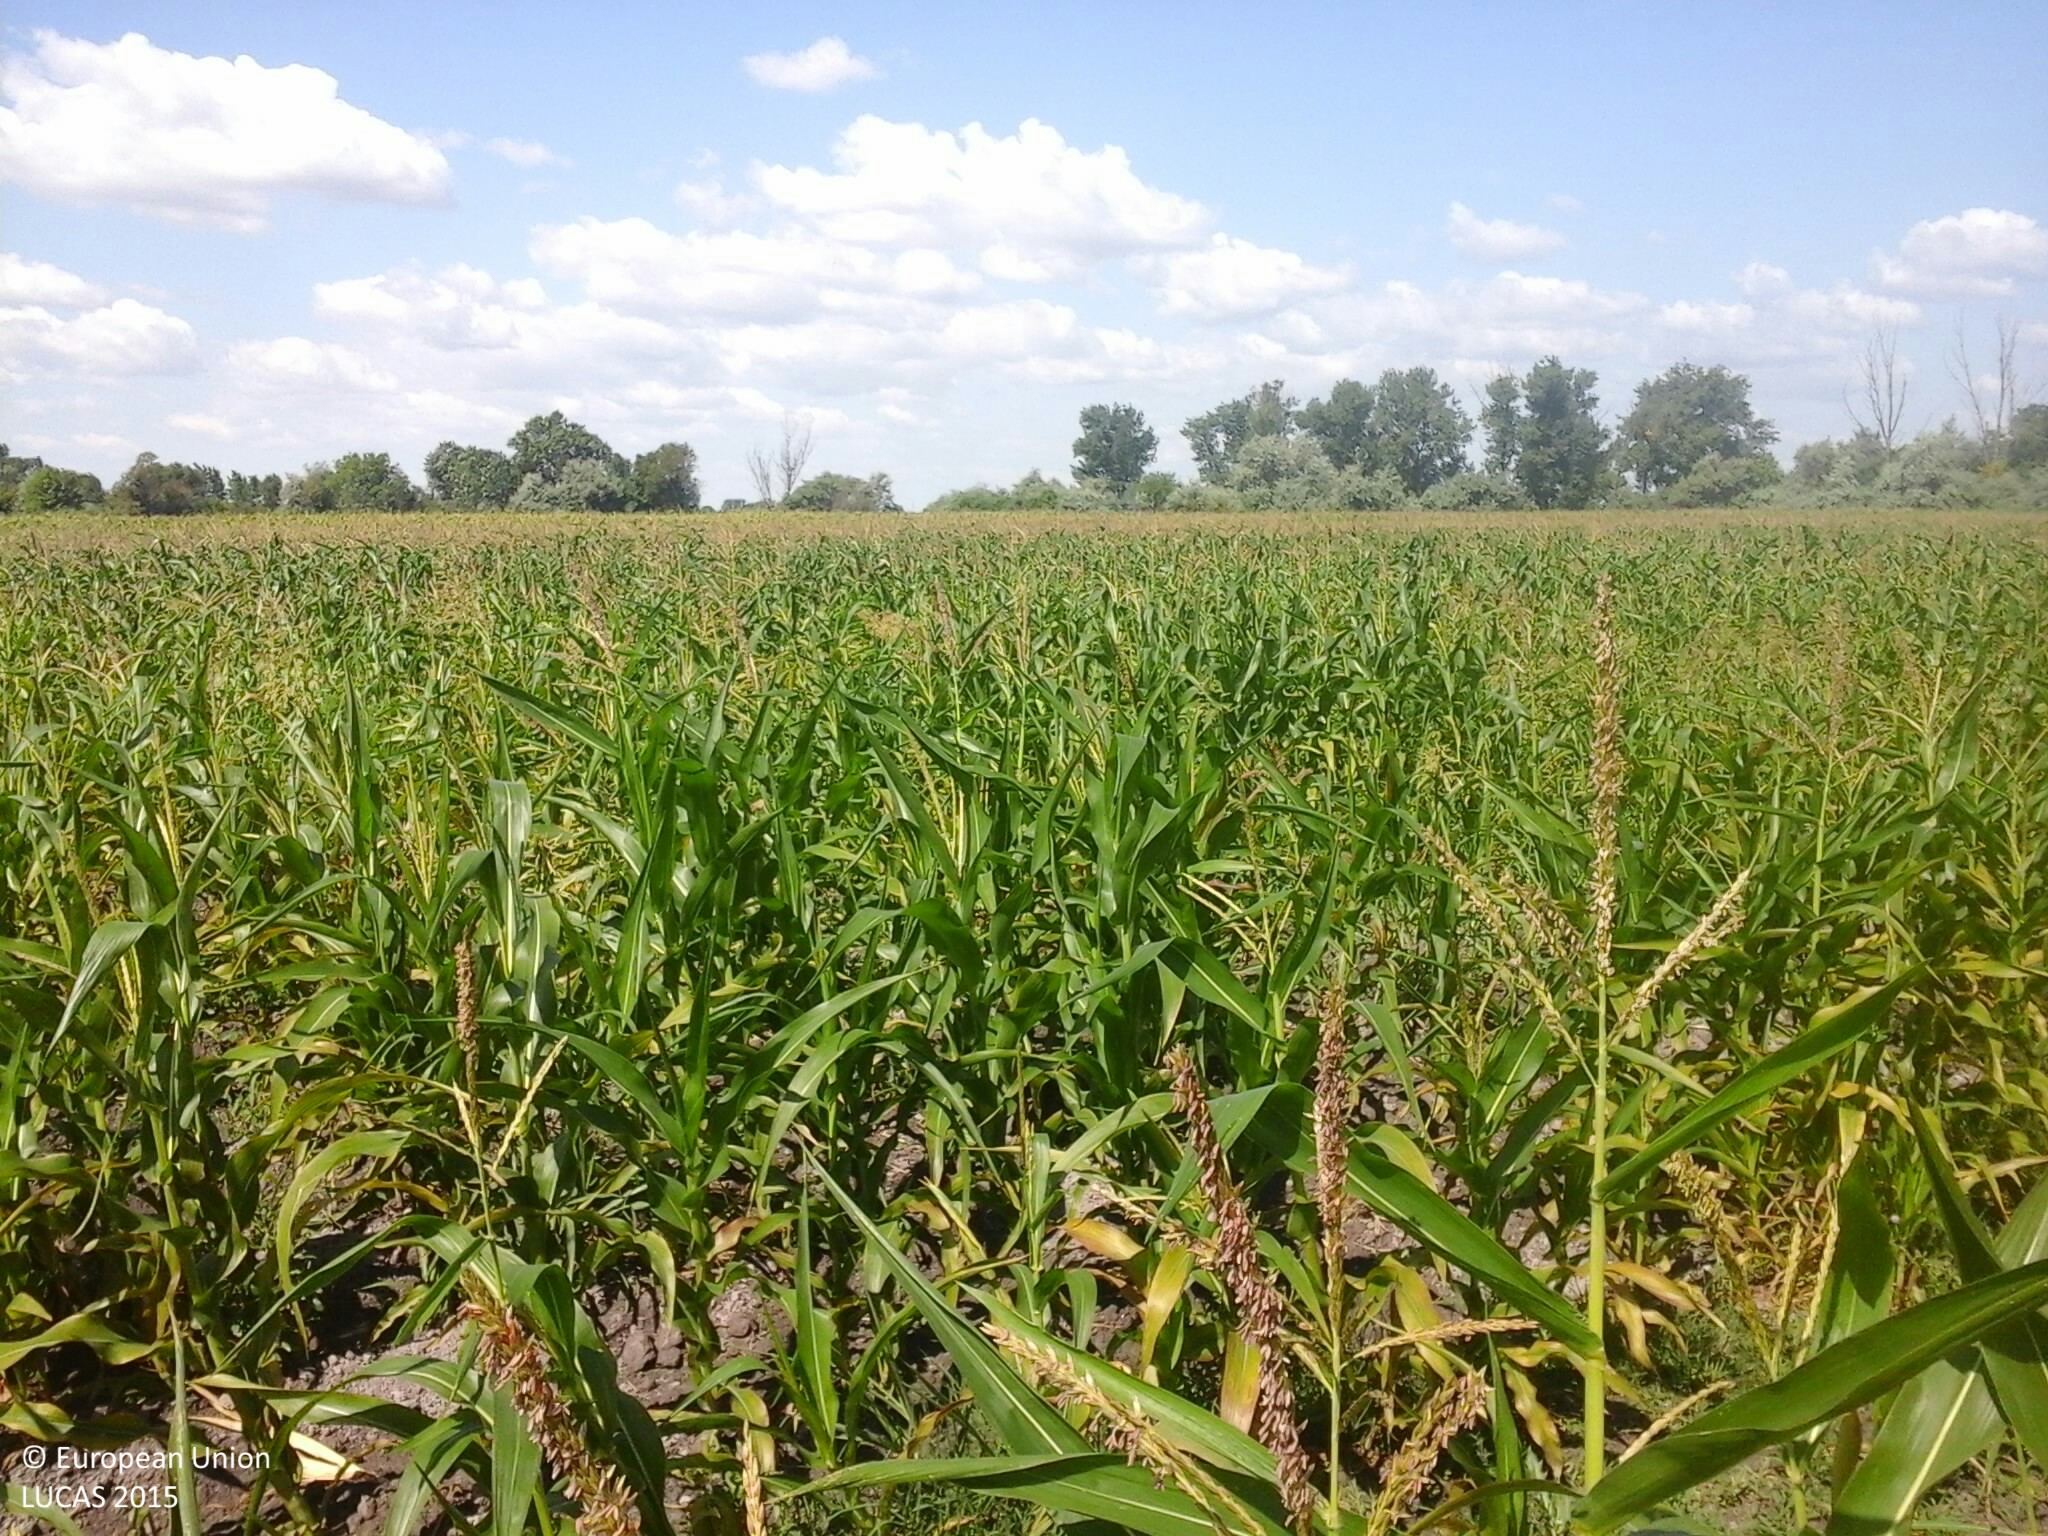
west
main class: Cropland
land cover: Maize
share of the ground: > 75 %
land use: Agriculture (excluding fallow land and kitchen gardens)
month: July
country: HU
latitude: 47.2026
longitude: 19.2191
